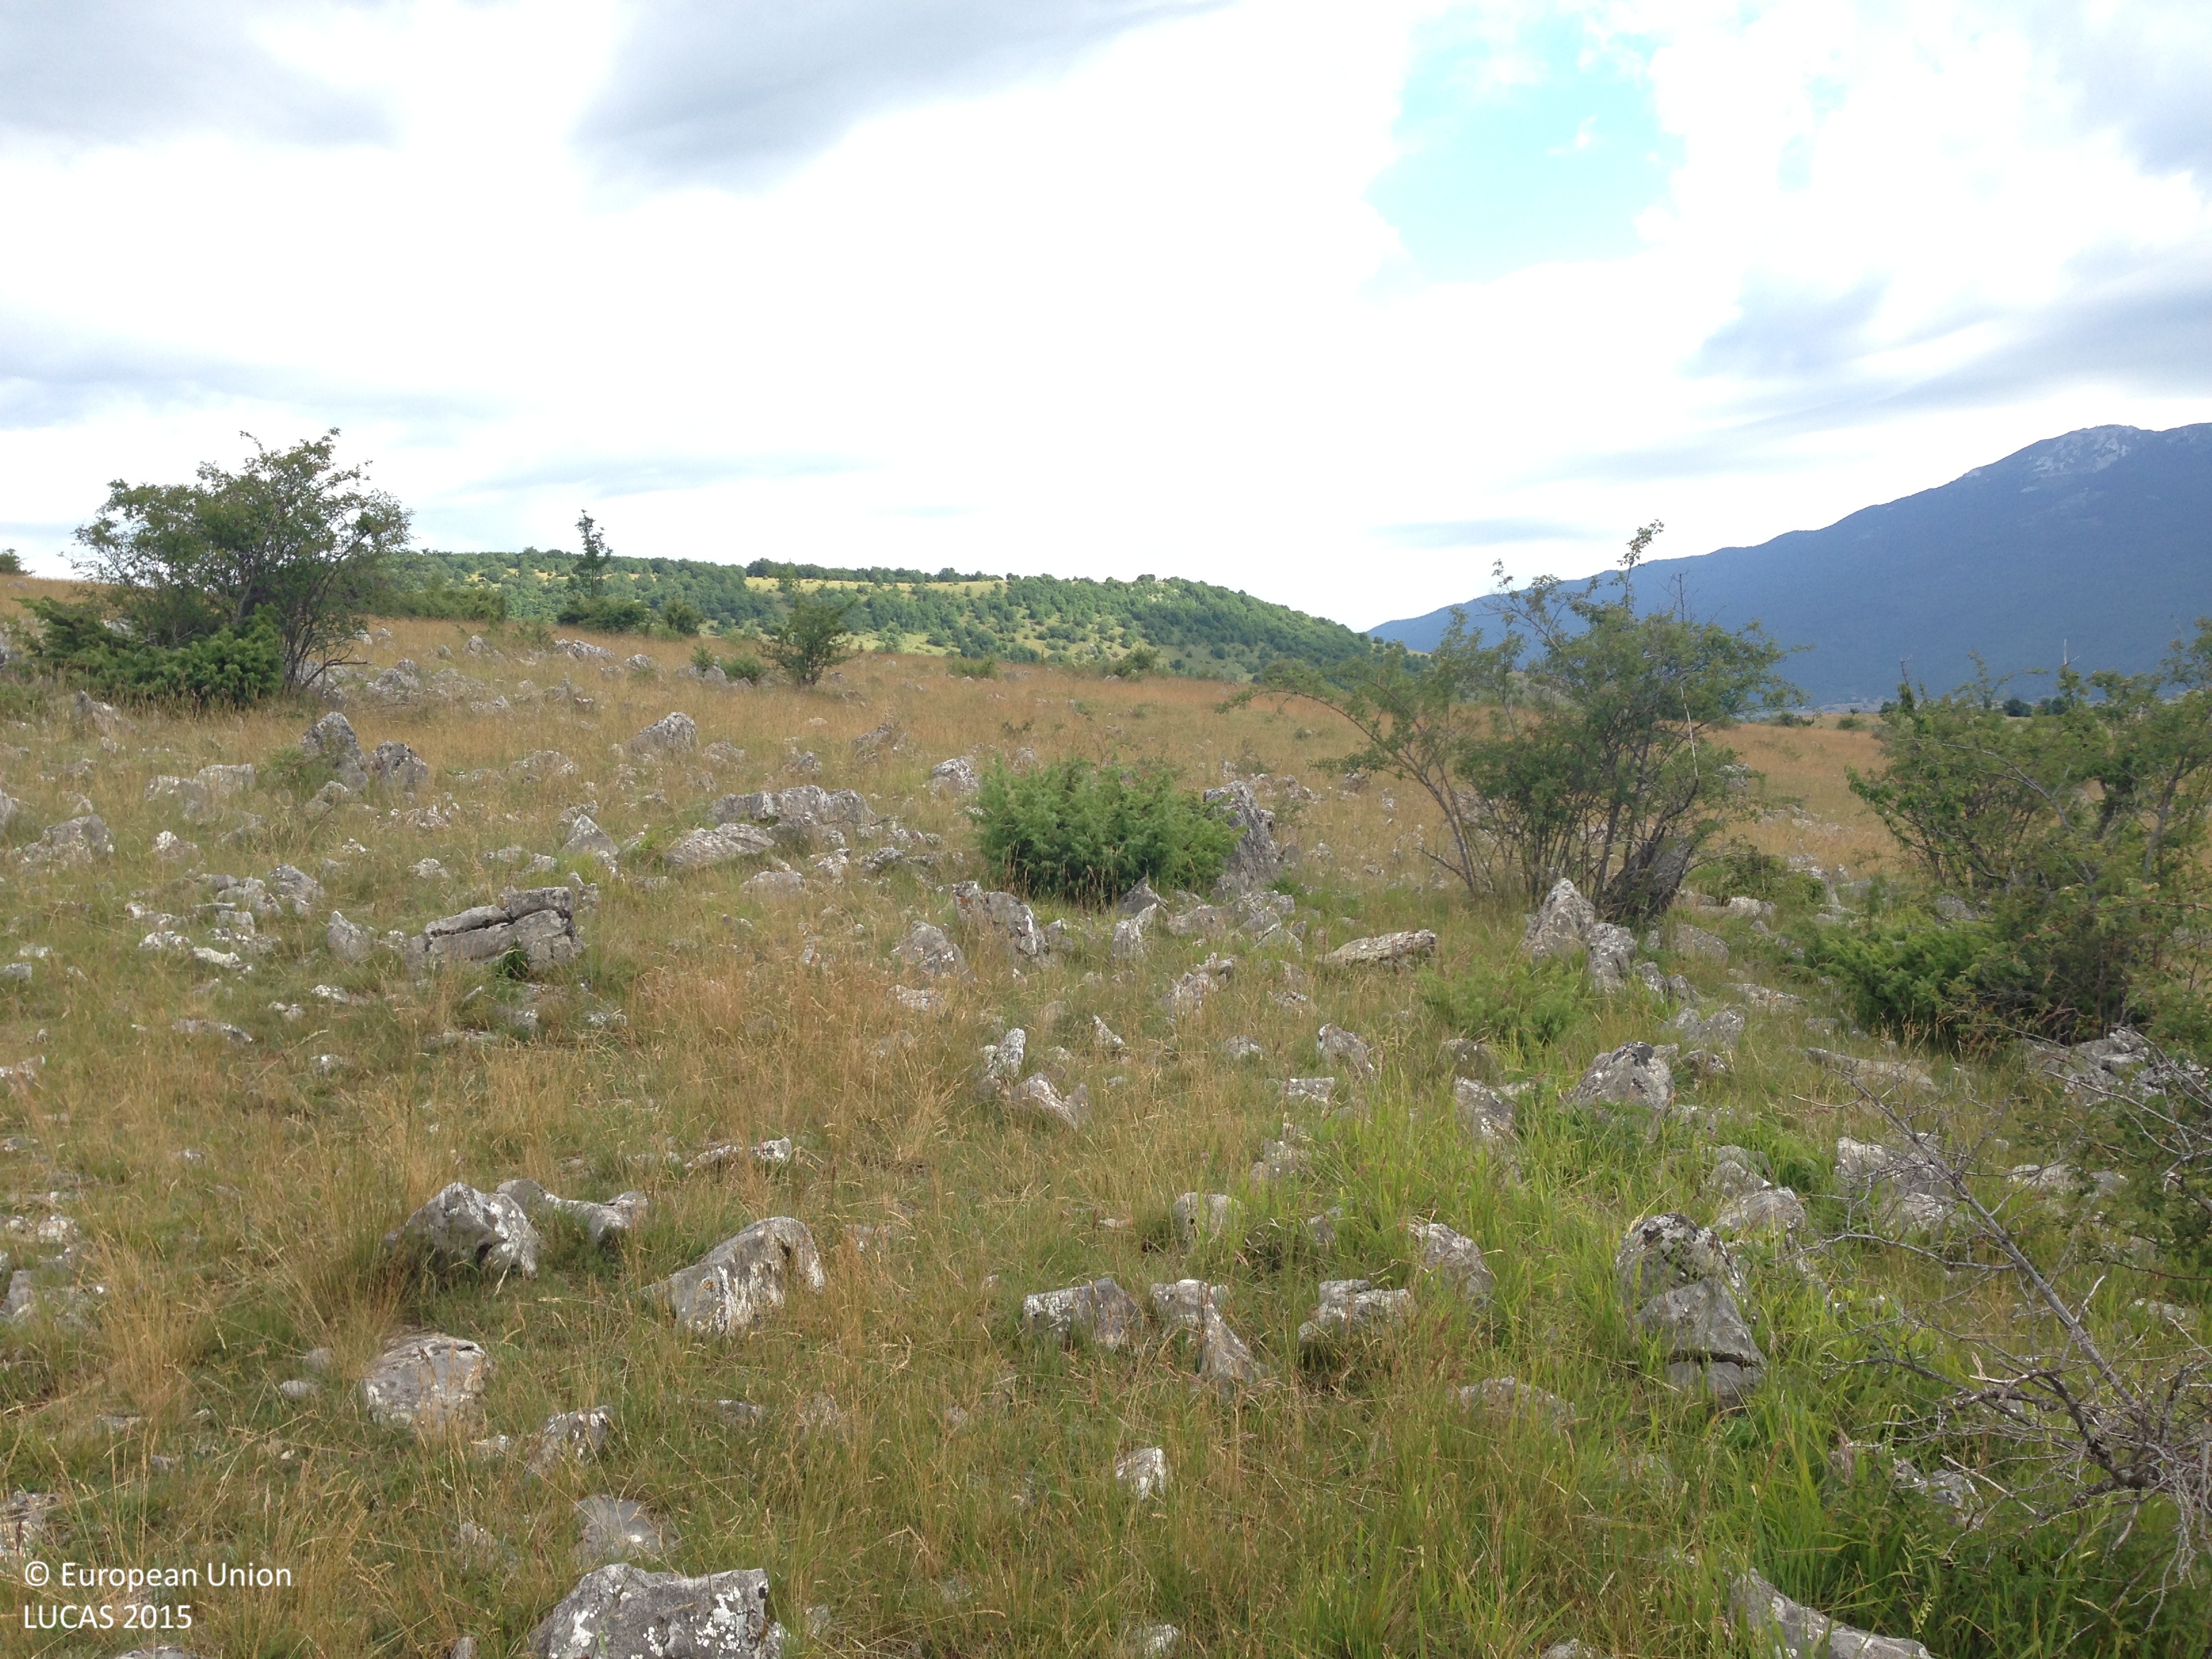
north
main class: Shrubland
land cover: Shrubland with sparse tree cover
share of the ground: 10 - 25 %
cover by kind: herbaceous plants 40 %, consolidated bare surface 25 %, shrubs 20 %, unconsolidated bare surface 10 %, coniferous forest trees 5 %
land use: Agriculture (excluding fallow land and kitchen gardens)
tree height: < 5 m
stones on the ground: < 10 %
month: June
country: HR
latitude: 44.7173
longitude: 15.7129
